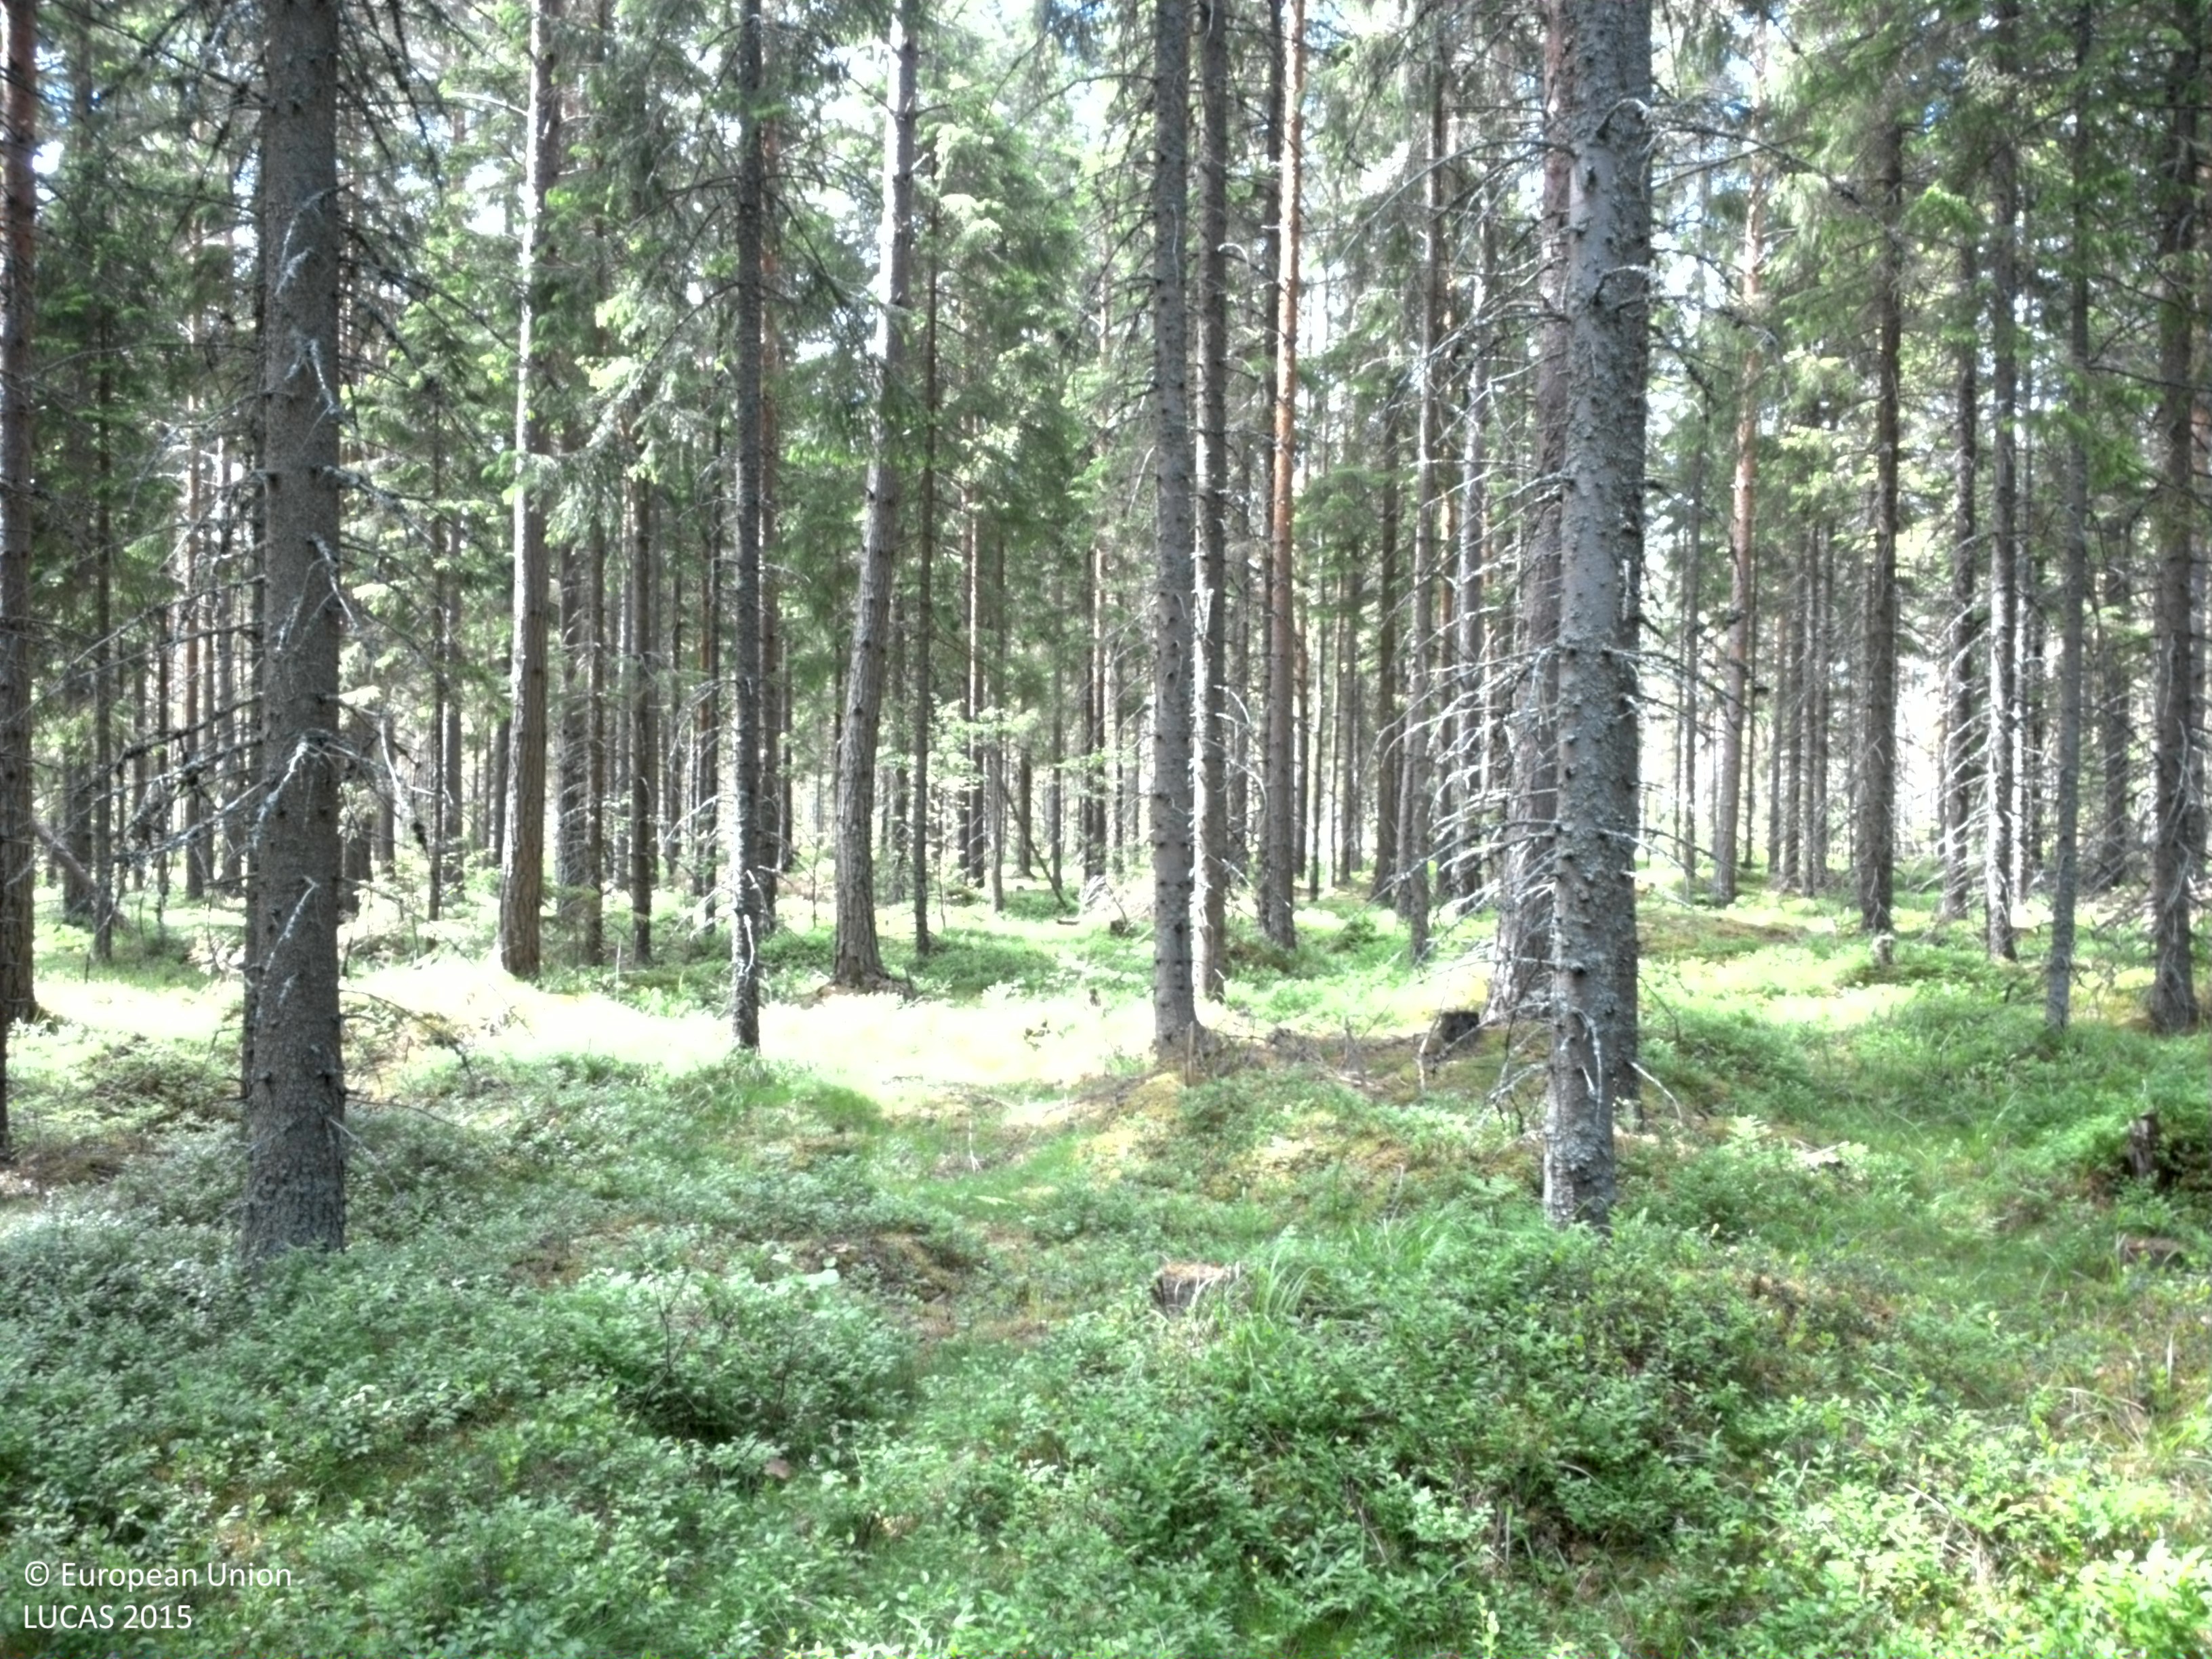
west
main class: Woodland
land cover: Spruce dominated coniferous woodland
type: boreal forest
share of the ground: 25 - 50 %
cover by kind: coniferous forest trees 45 %, lichens and mosses 35 %, herbaceous plants 20 %
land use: Forestry
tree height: > 5 m
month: June
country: SE
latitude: 60.2232
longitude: 17.0129
